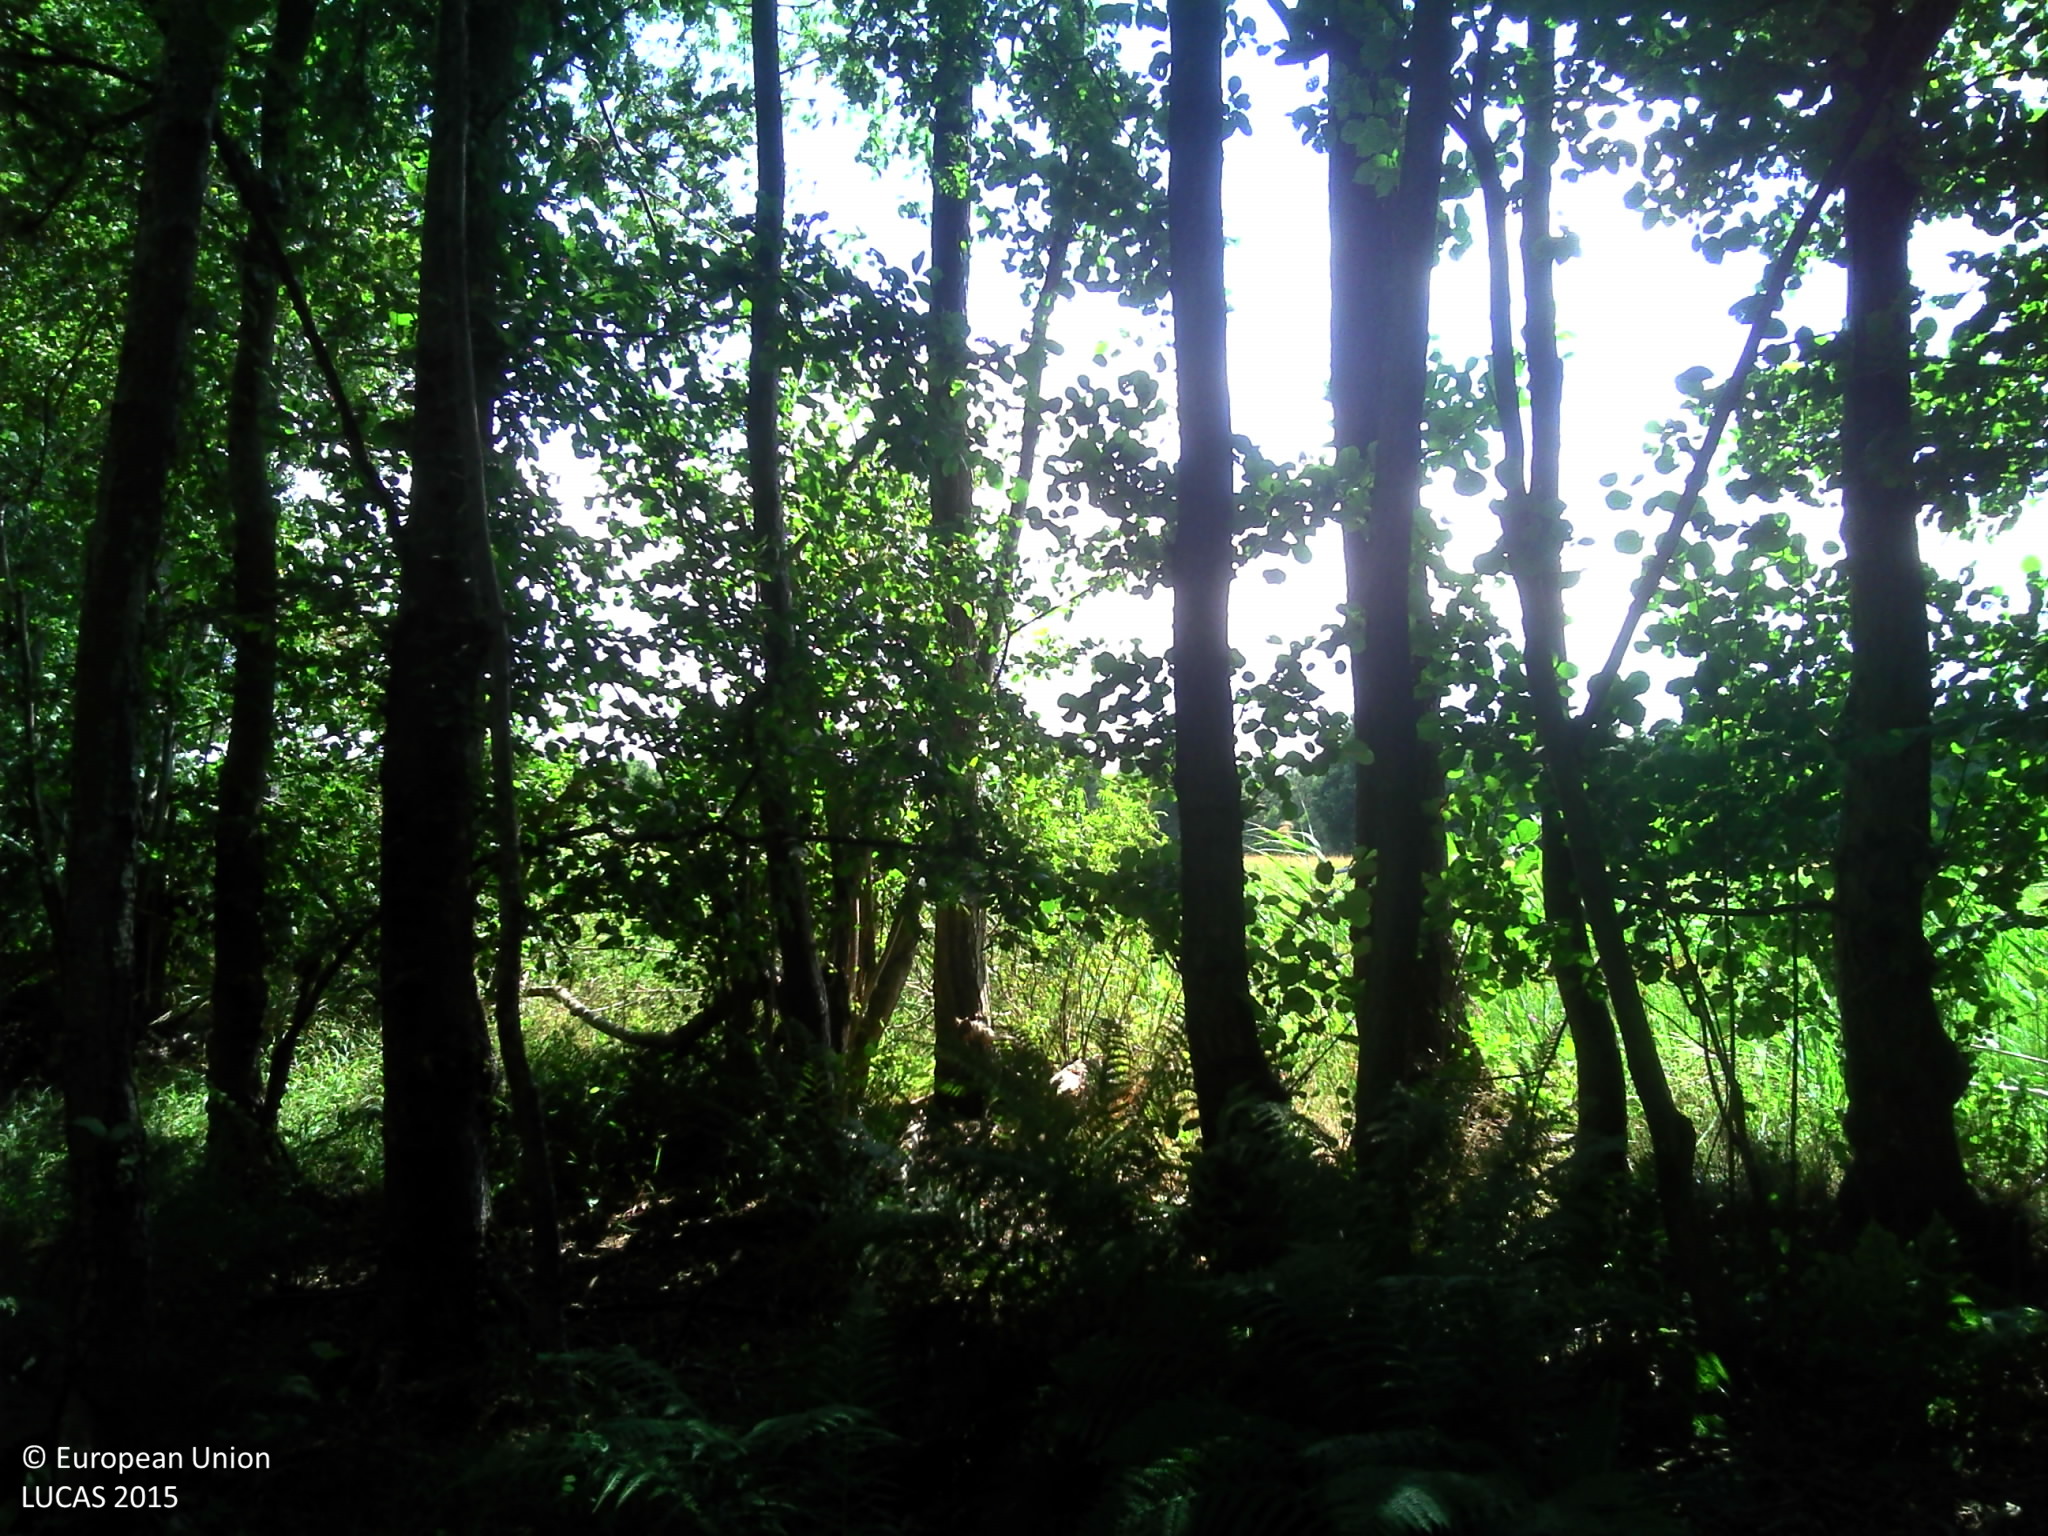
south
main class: Woodland
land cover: Broadleaved woodland
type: mesophytic deciduous forest
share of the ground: > 75 %
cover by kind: broadleaved forest trees 95 %, herbaceous plants 5 %
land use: Forestry
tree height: > 5 m
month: July
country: FR
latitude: 48.8301
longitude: 7.7257
